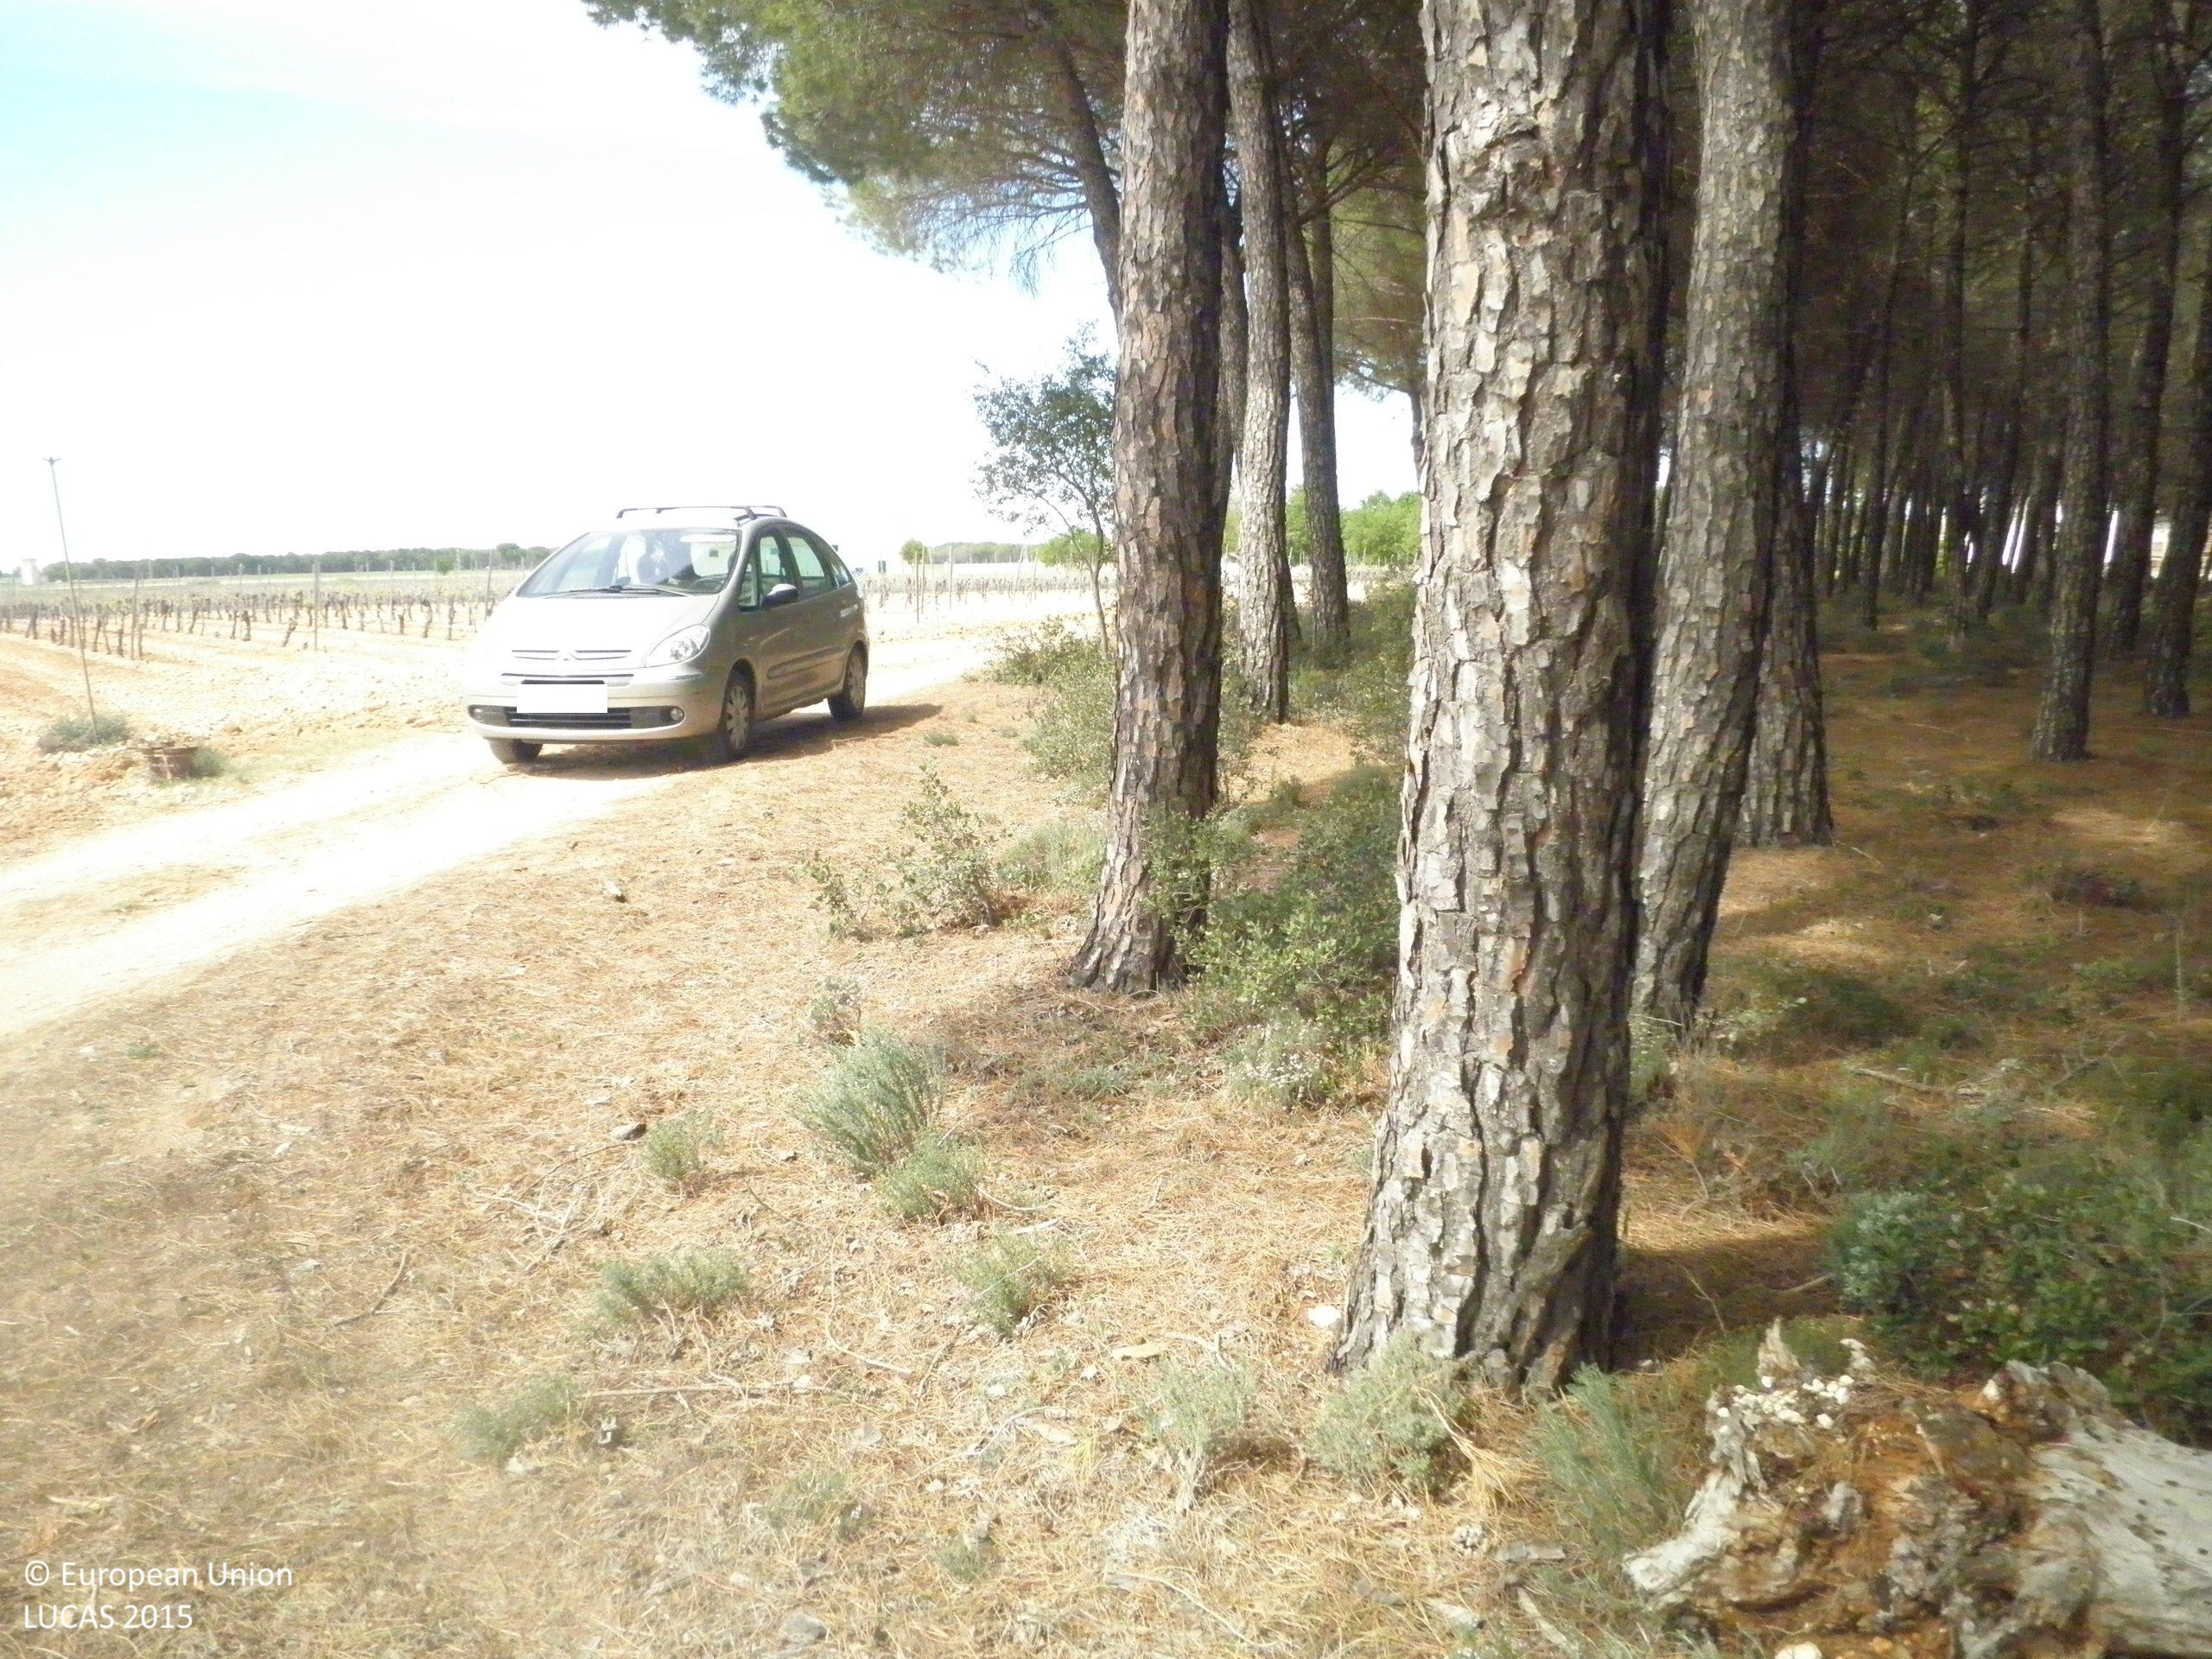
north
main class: Woodland
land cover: Pine dominated coniferous woodland
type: coniferous forest of the mediterranean region
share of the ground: > 75 %
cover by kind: coniferous forest trees 70 %, shrubs 10 %, herbaceous plants 10 %, unconsolidated bare surface 10 %
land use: Semi-natural and natural areas not in use
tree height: > 5 m
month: April
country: ES
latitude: 39.3862
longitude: -2.6789
